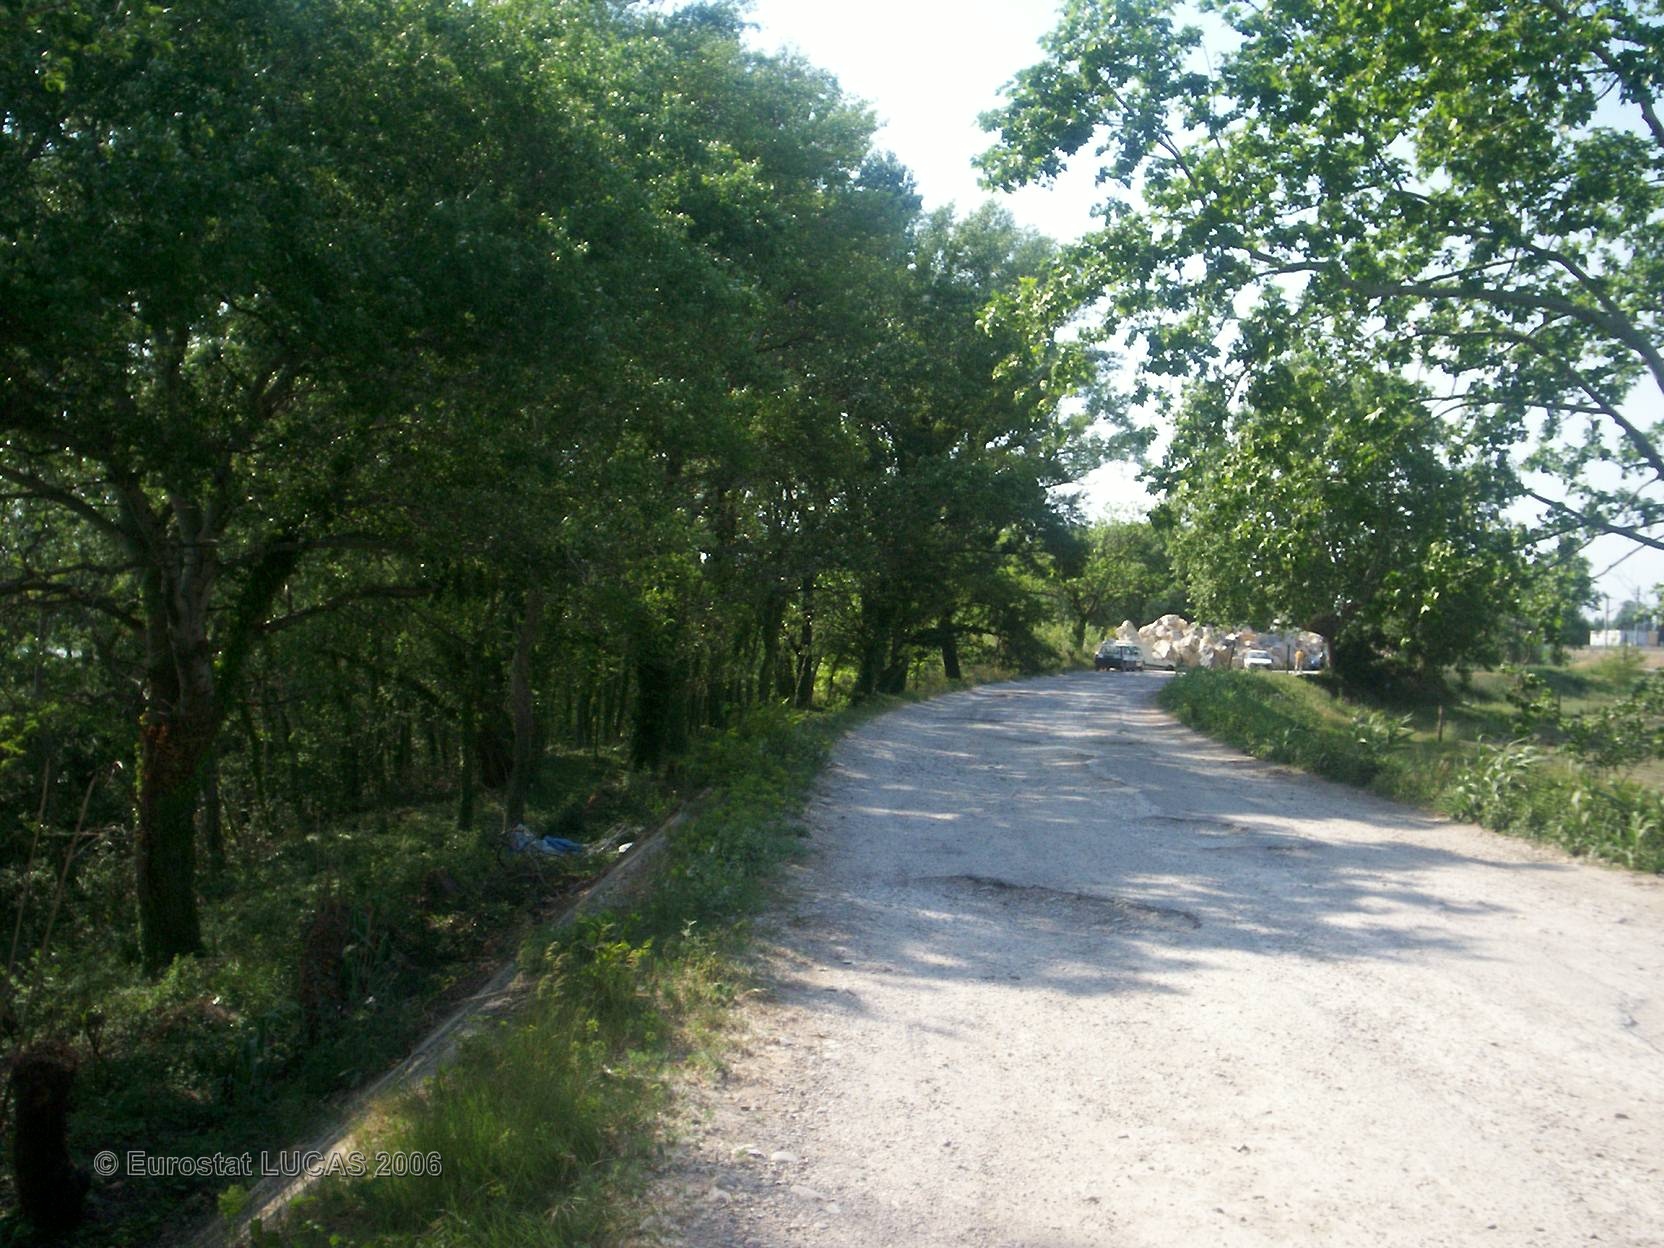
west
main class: Grassland
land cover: Grassland without tree/shrub cover
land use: Agriculture (excluding fallow land and kitchen gardens)
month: May
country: FR
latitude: 43.8995
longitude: 4.8918
